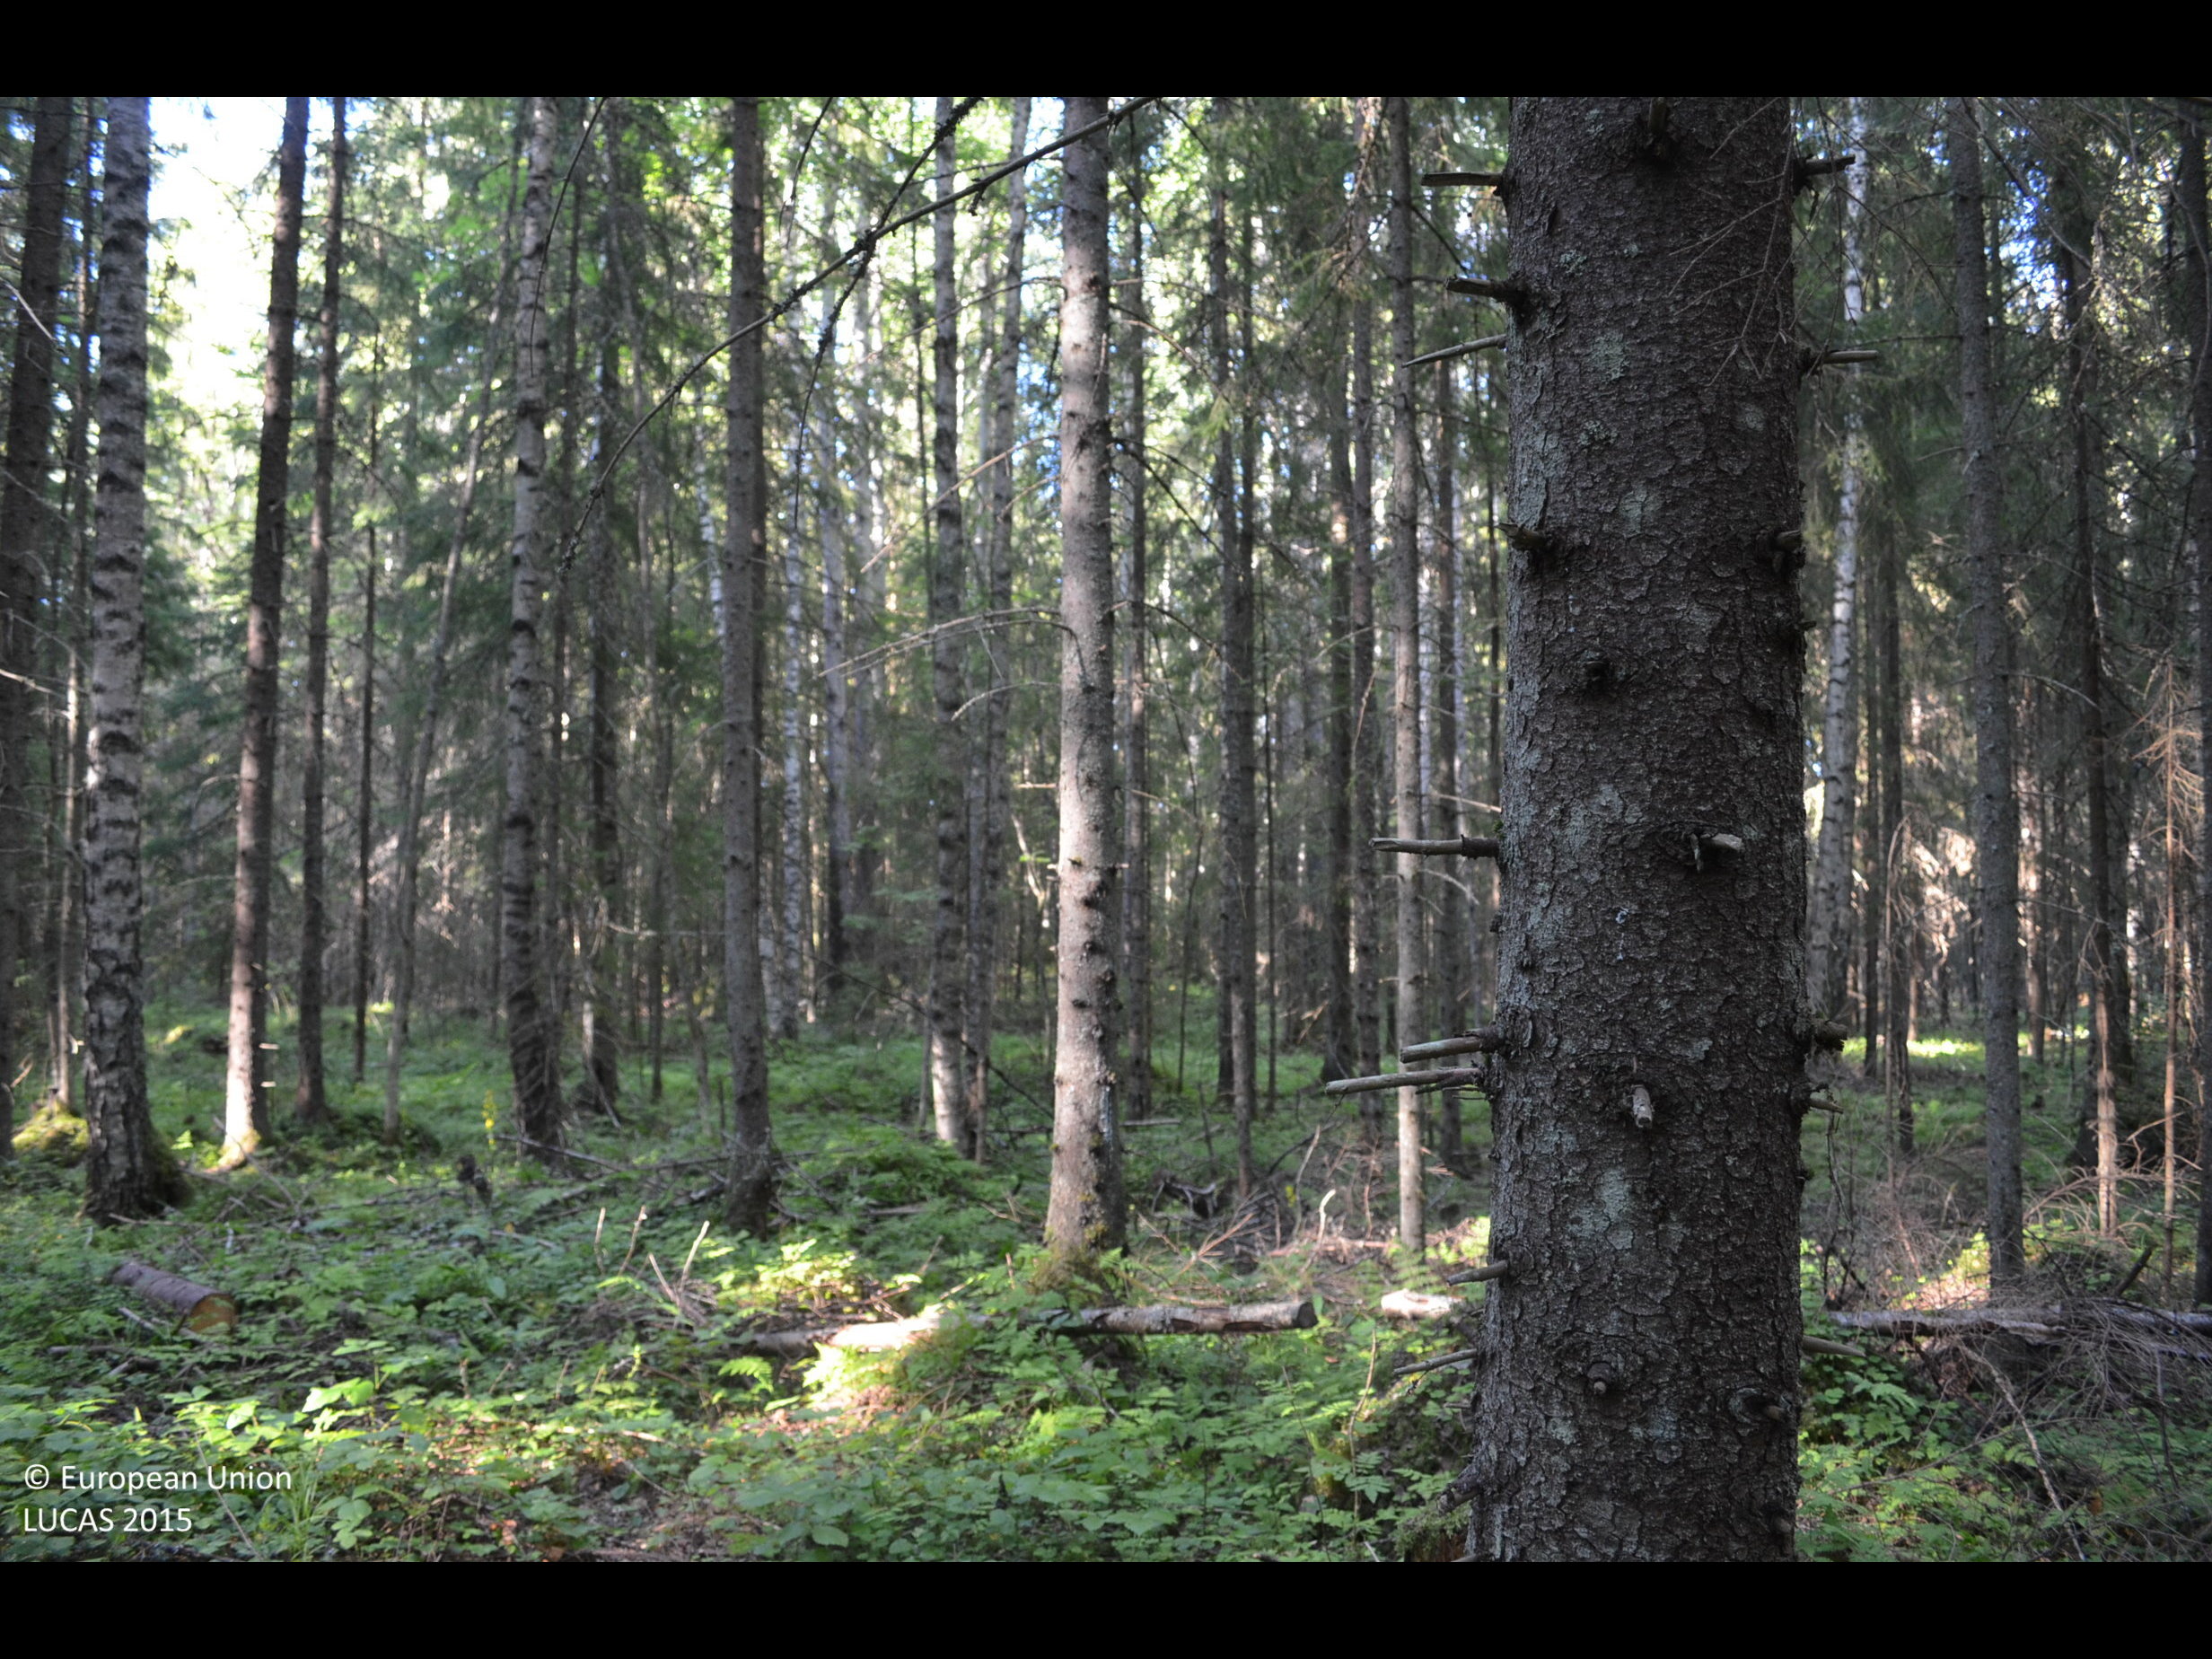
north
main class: Woodland
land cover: Spruce dominated mixed woodland
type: boreal forest
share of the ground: > 75 %
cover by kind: coniferous forest trees 50 %, broadleaved forest trees 40 %, shrubs 5 %, herbaceous plants 5 %
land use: Forestry
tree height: > 5 m
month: August
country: FI
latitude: 61.5802
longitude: 23.0869
